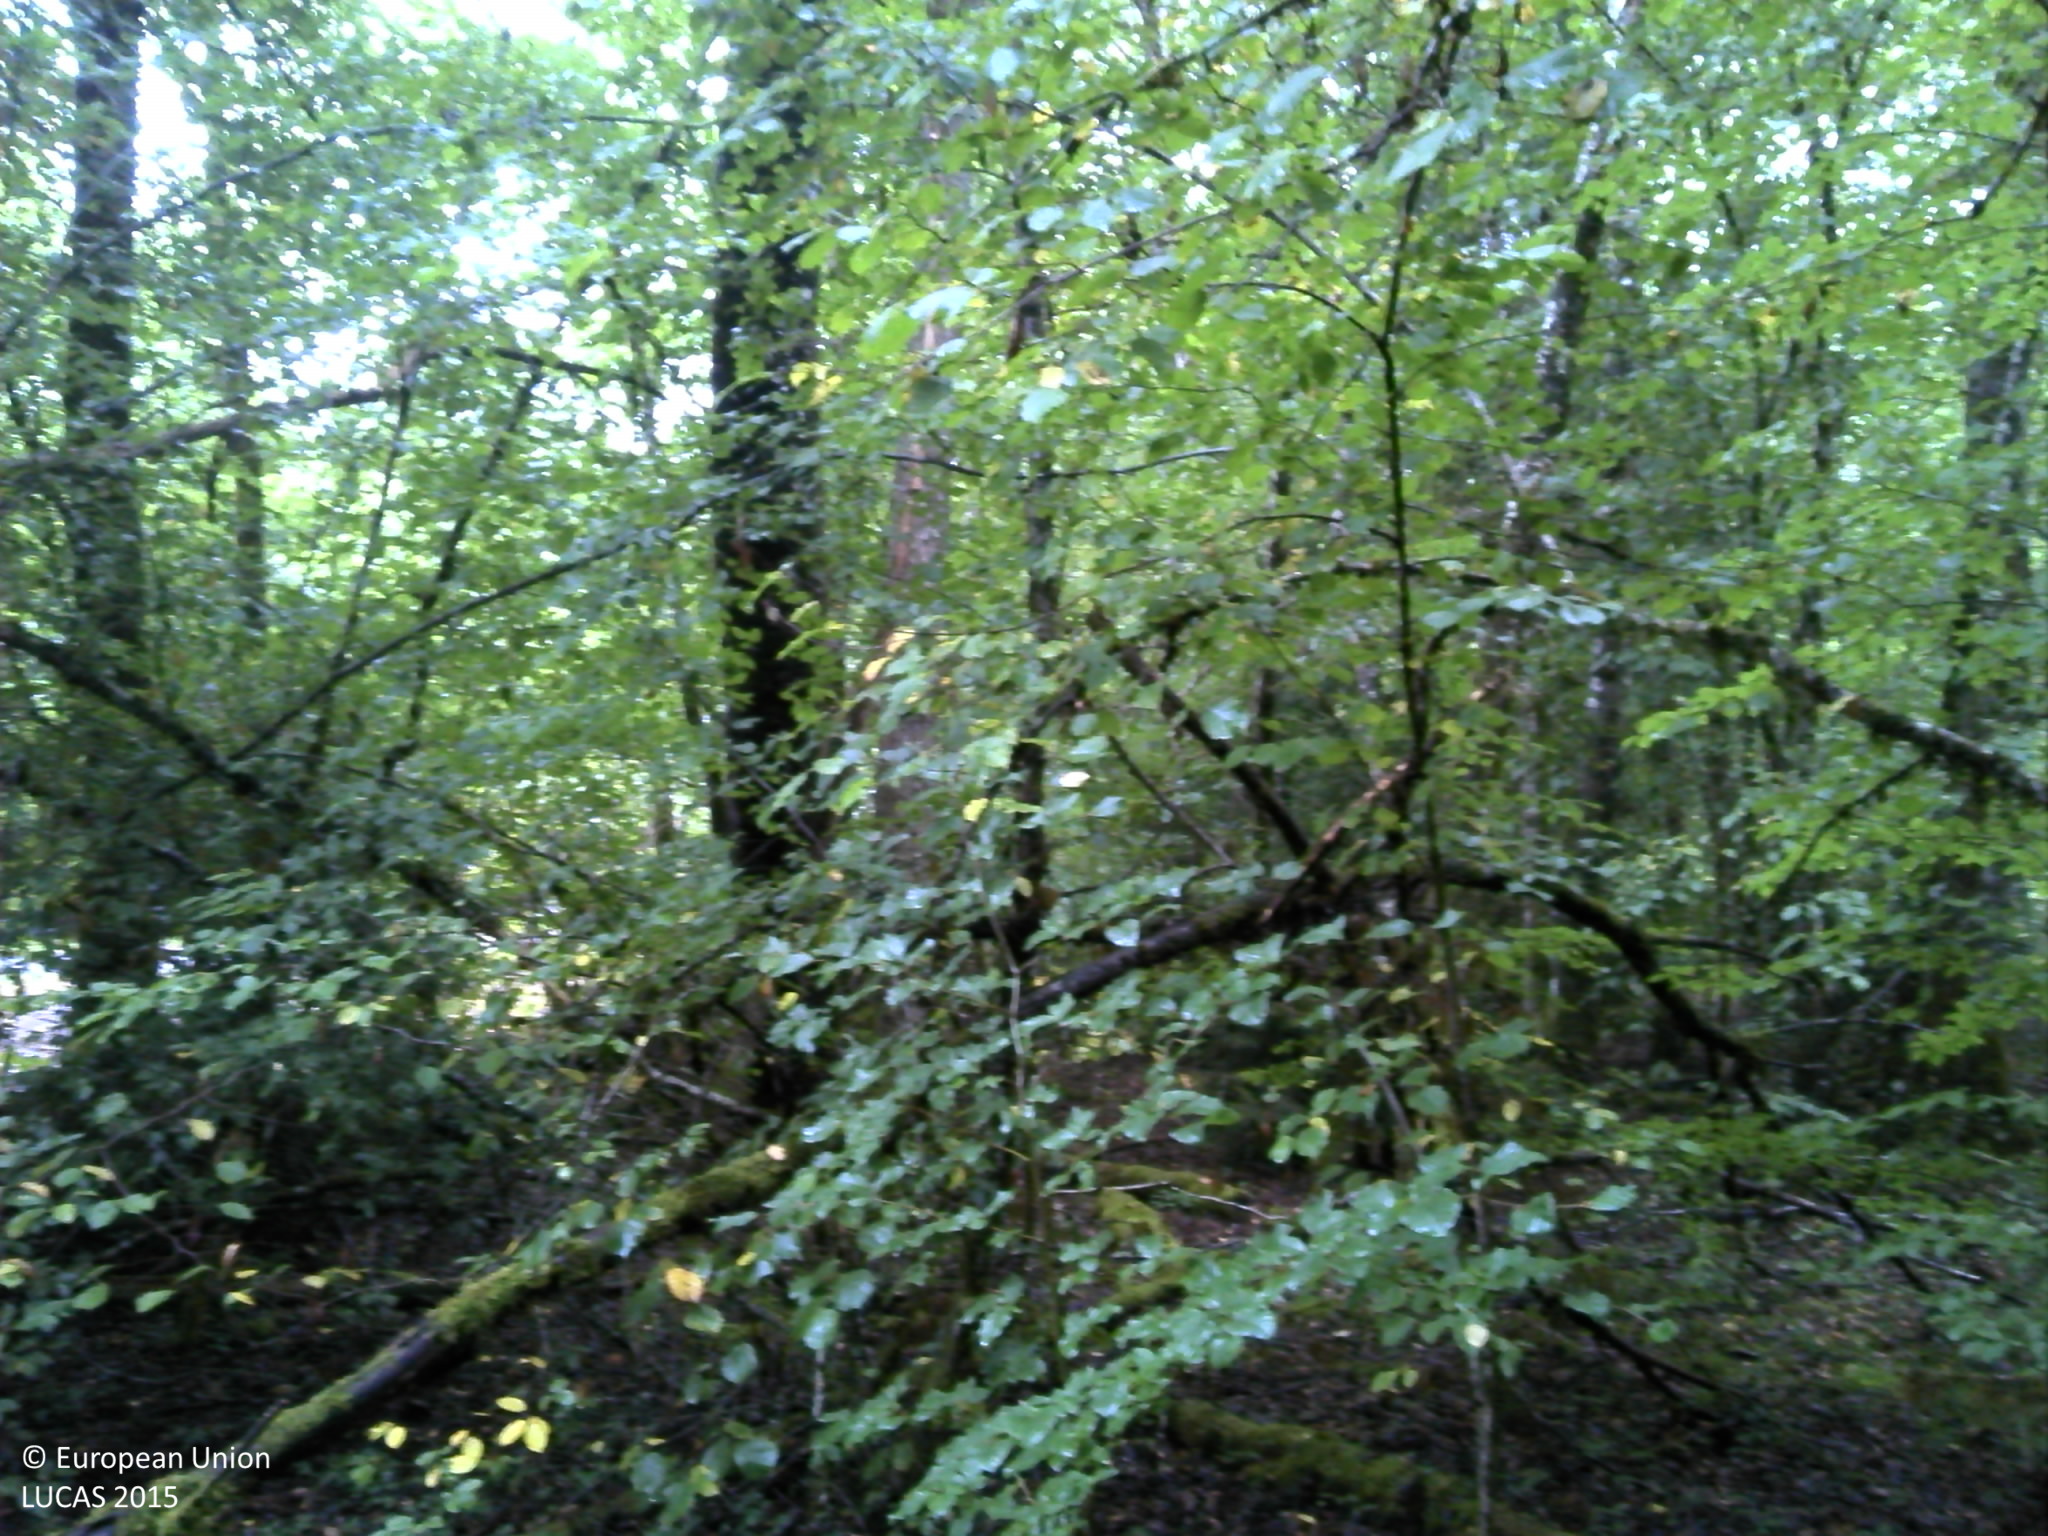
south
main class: Woodland
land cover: Spruce dominated mixed woodland
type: mountainous beech forest
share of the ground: > 75 %
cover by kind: broadleaved forest trees 35 %, coniferous forest trees 30 %, lichens and mosses 20 %, unconsolidated bare surface 15 %
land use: Semi-natural and natural areas not in use
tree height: > 5 m
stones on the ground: < 10 %
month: August
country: FR
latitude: 45.4270
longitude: 2.3679
